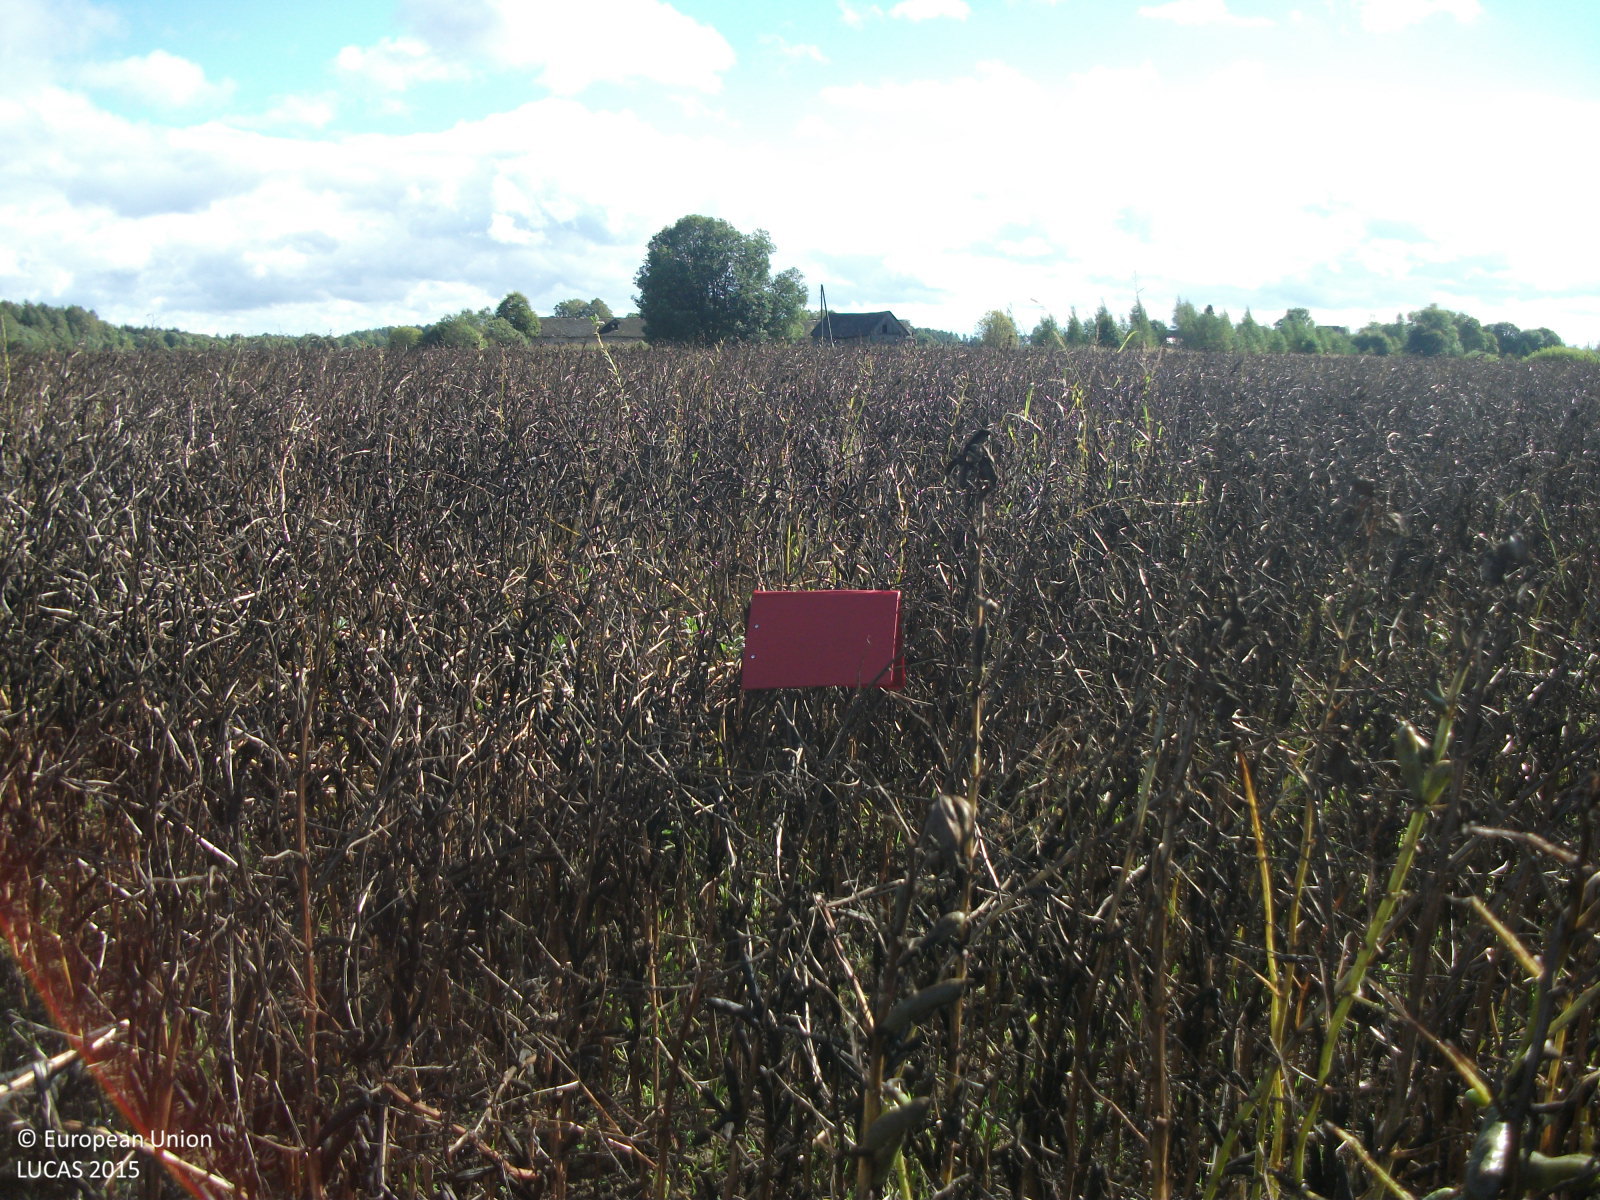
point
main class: Cropland
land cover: Dry pulses
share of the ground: > 75 %
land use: Agriculture (excluding fallow land and kitchen gardens)
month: September
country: LV
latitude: 57.6962
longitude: 24.8795
